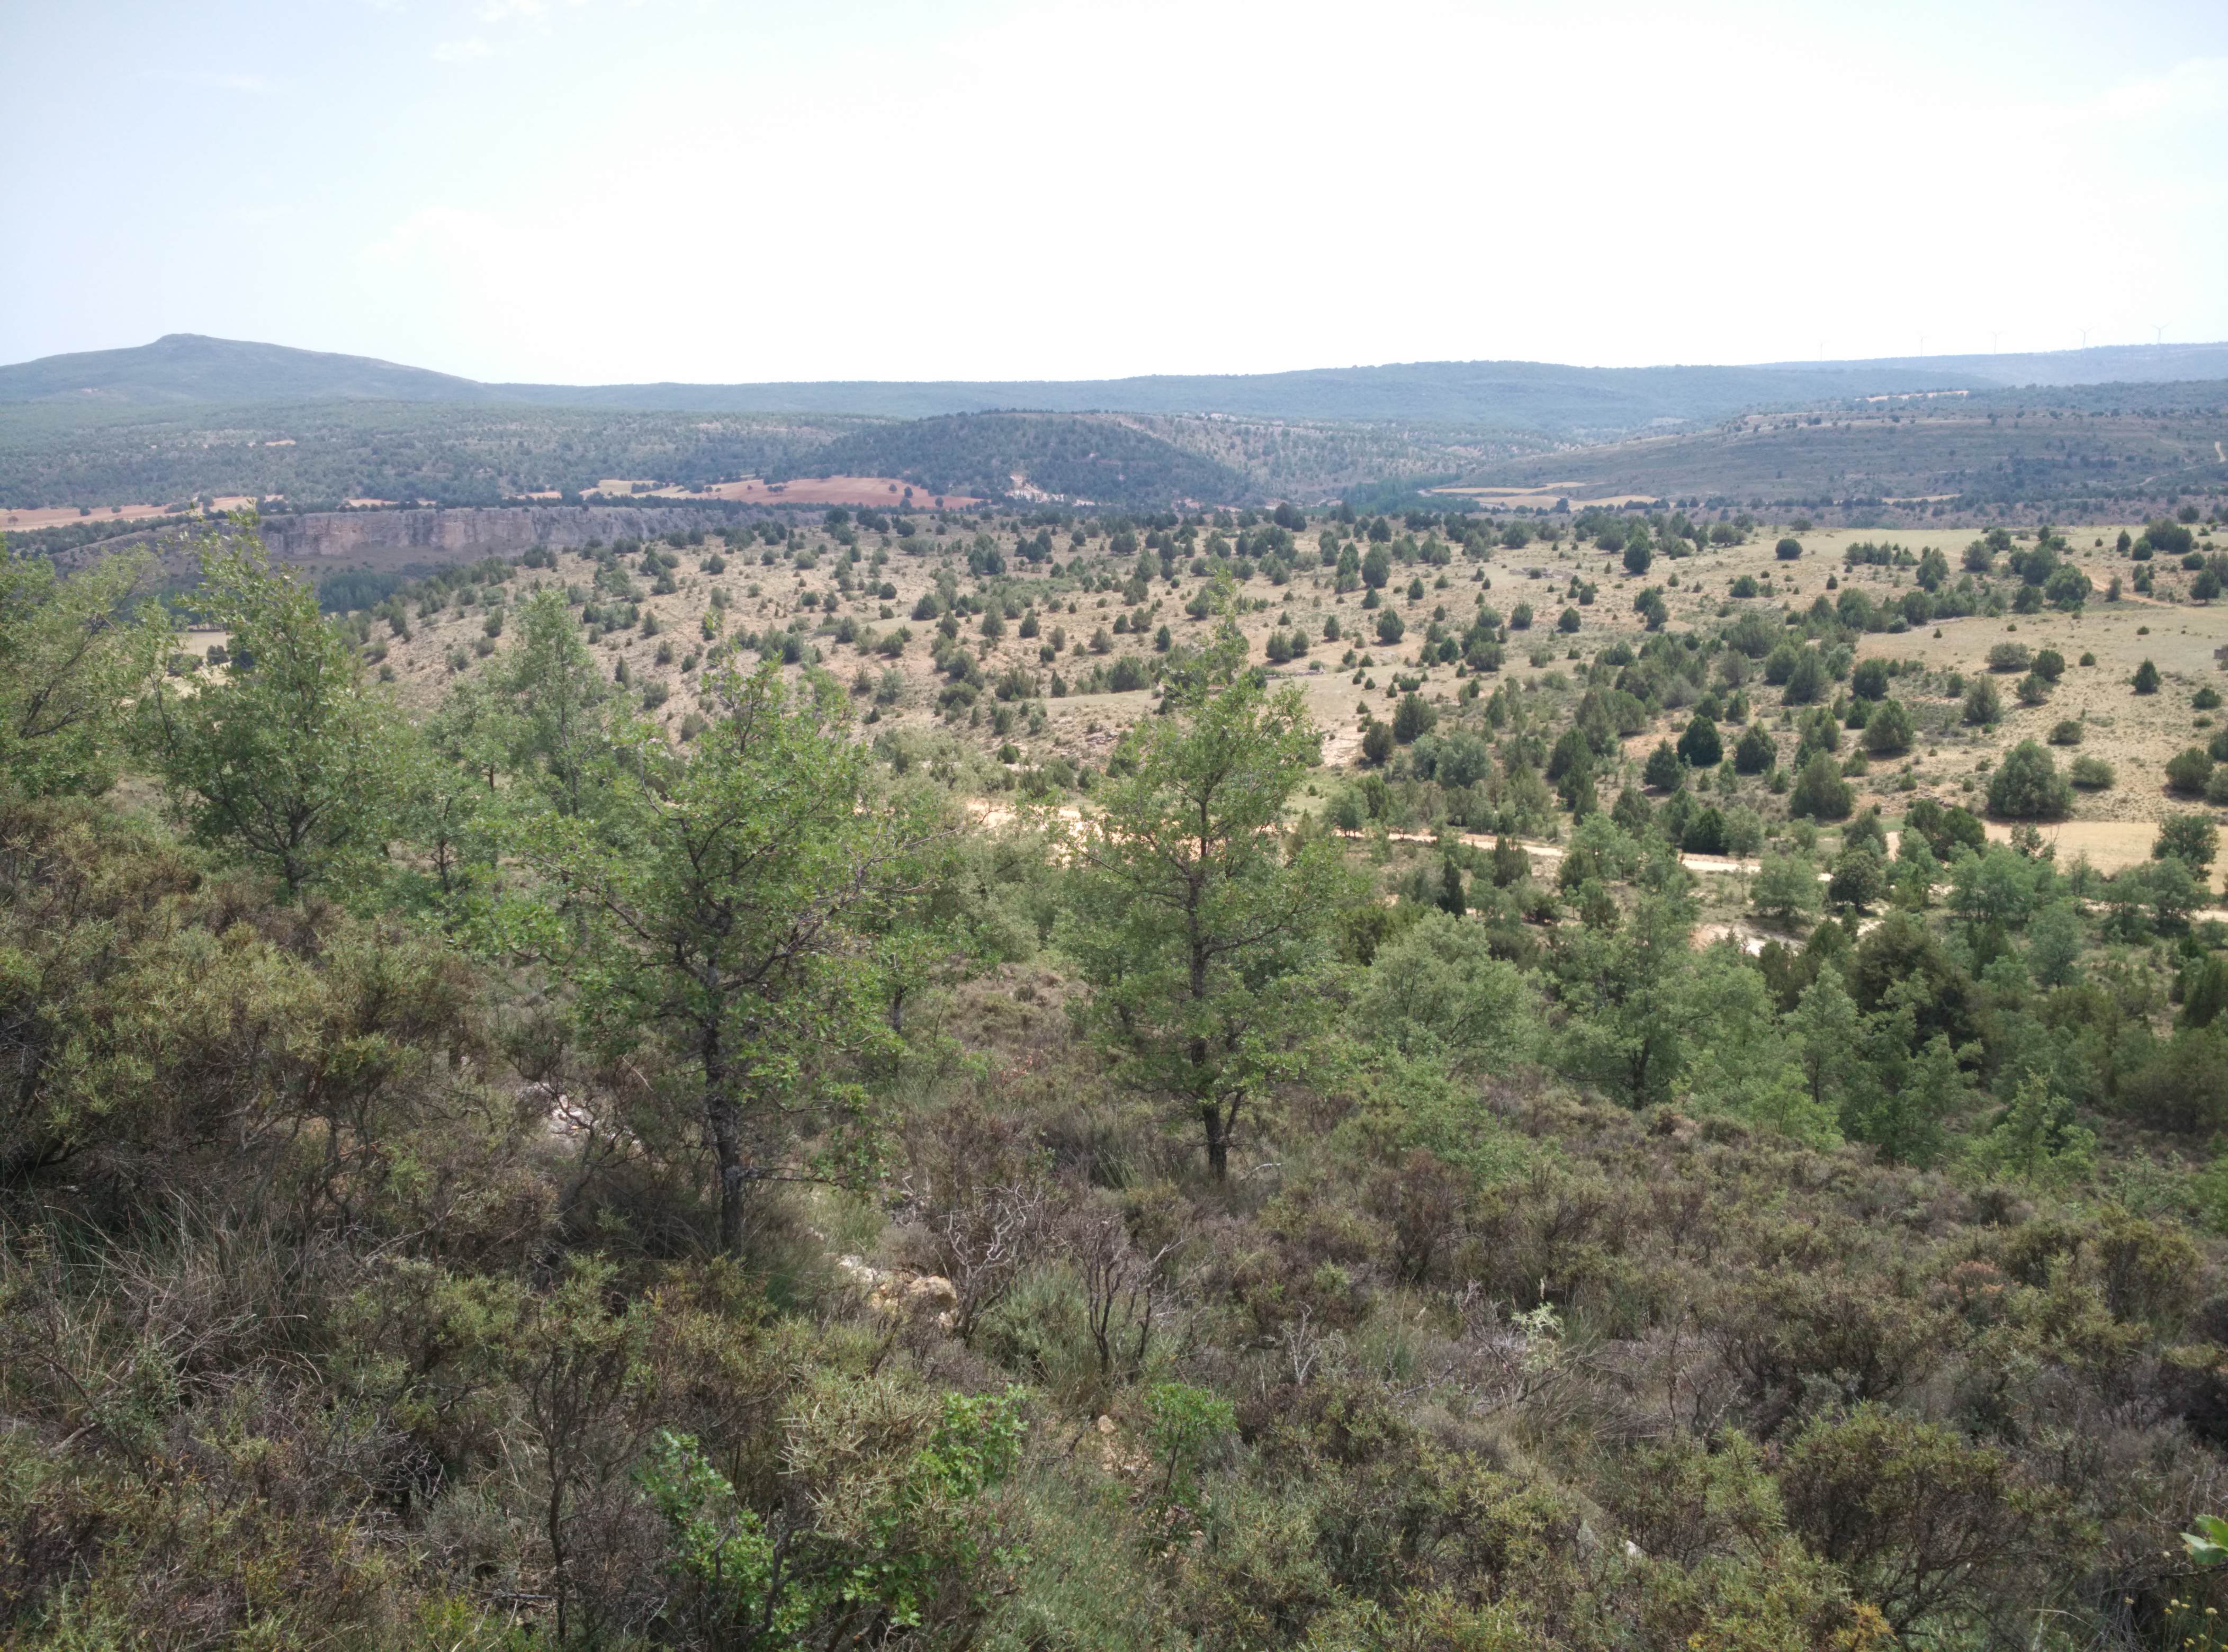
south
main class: Shrubland
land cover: Shrubland with sparse tree cover
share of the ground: > 75 %
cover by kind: shrubs 80 %, unconsolidated bare surface 15 %, broadleaved forest trees 5 %
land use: Semi-natural and natural areas not in use
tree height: > 5 m
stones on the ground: > 50 %
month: July
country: ES
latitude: 41.0139
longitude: -2.0954
